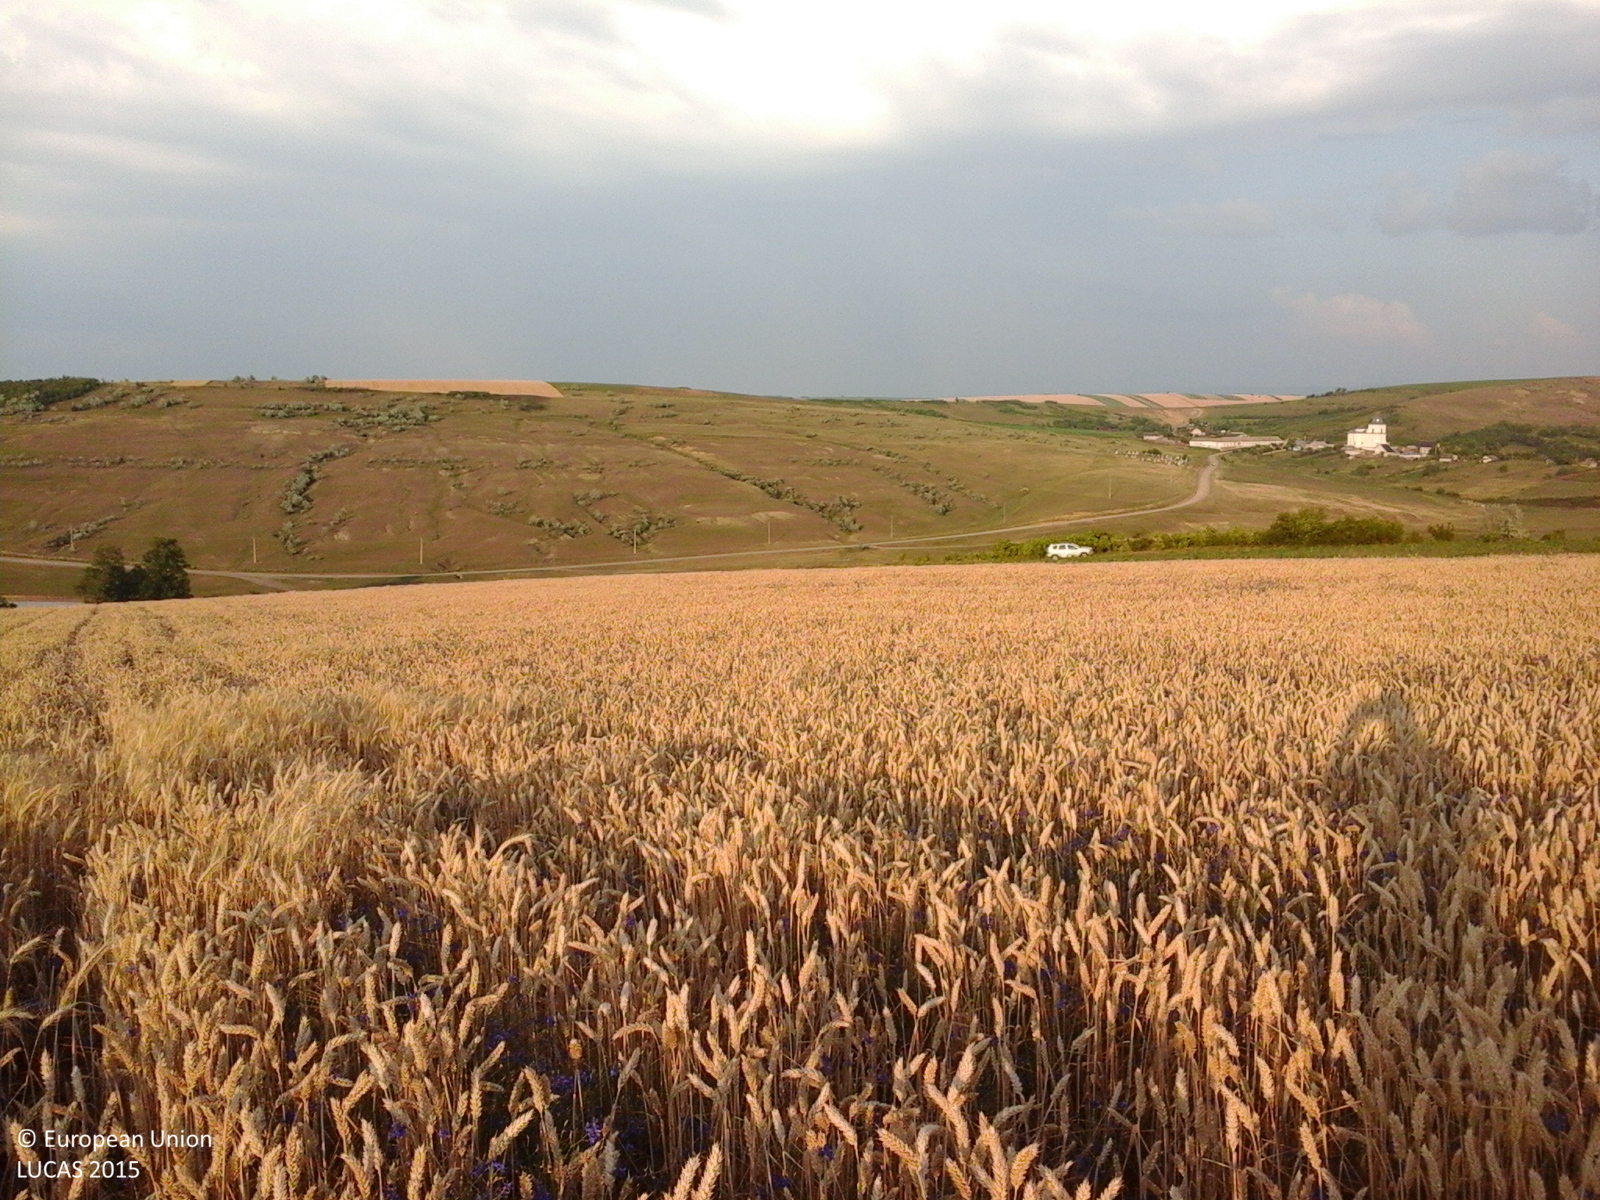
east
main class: Cropland
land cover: Common wheat
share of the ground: > 75 %
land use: Agriculture (excluding fallow land and kitchen gardens)
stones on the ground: < 10 %
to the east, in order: Common wheat; Grassland without tree/shrub cover; Tracks; Grassland without tree/shrub cover; Grassland with sparse tree/shrub cover
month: June
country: RO
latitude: 47.1560
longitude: 27.4042
